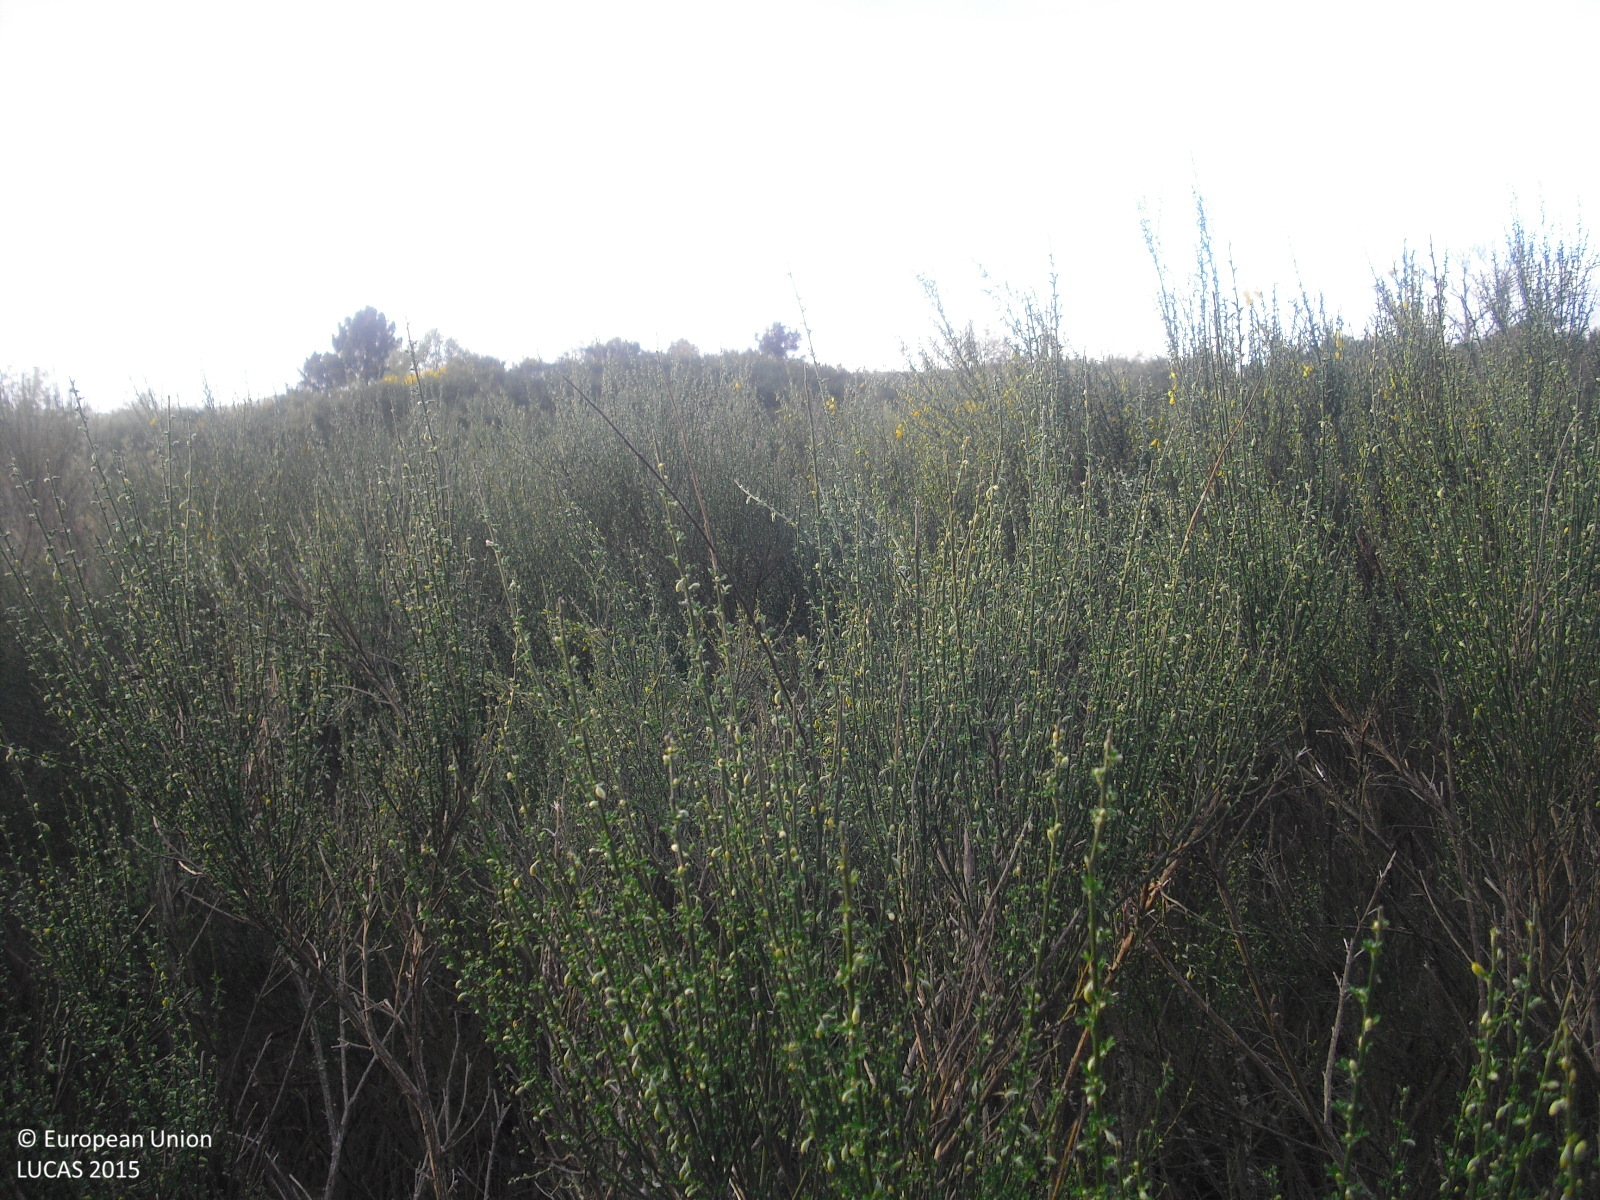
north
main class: Shrubland
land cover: Shrubland with sparse tree cover
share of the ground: 50 - 75 %
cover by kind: shrubs 75 %, consolidated bare surface 20 %, coniferous forest trees 5 %
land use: Semi-natural and natural areas not in use
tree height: < 5 m
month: April
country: ES
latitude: 41.9082
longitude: -7.5056
